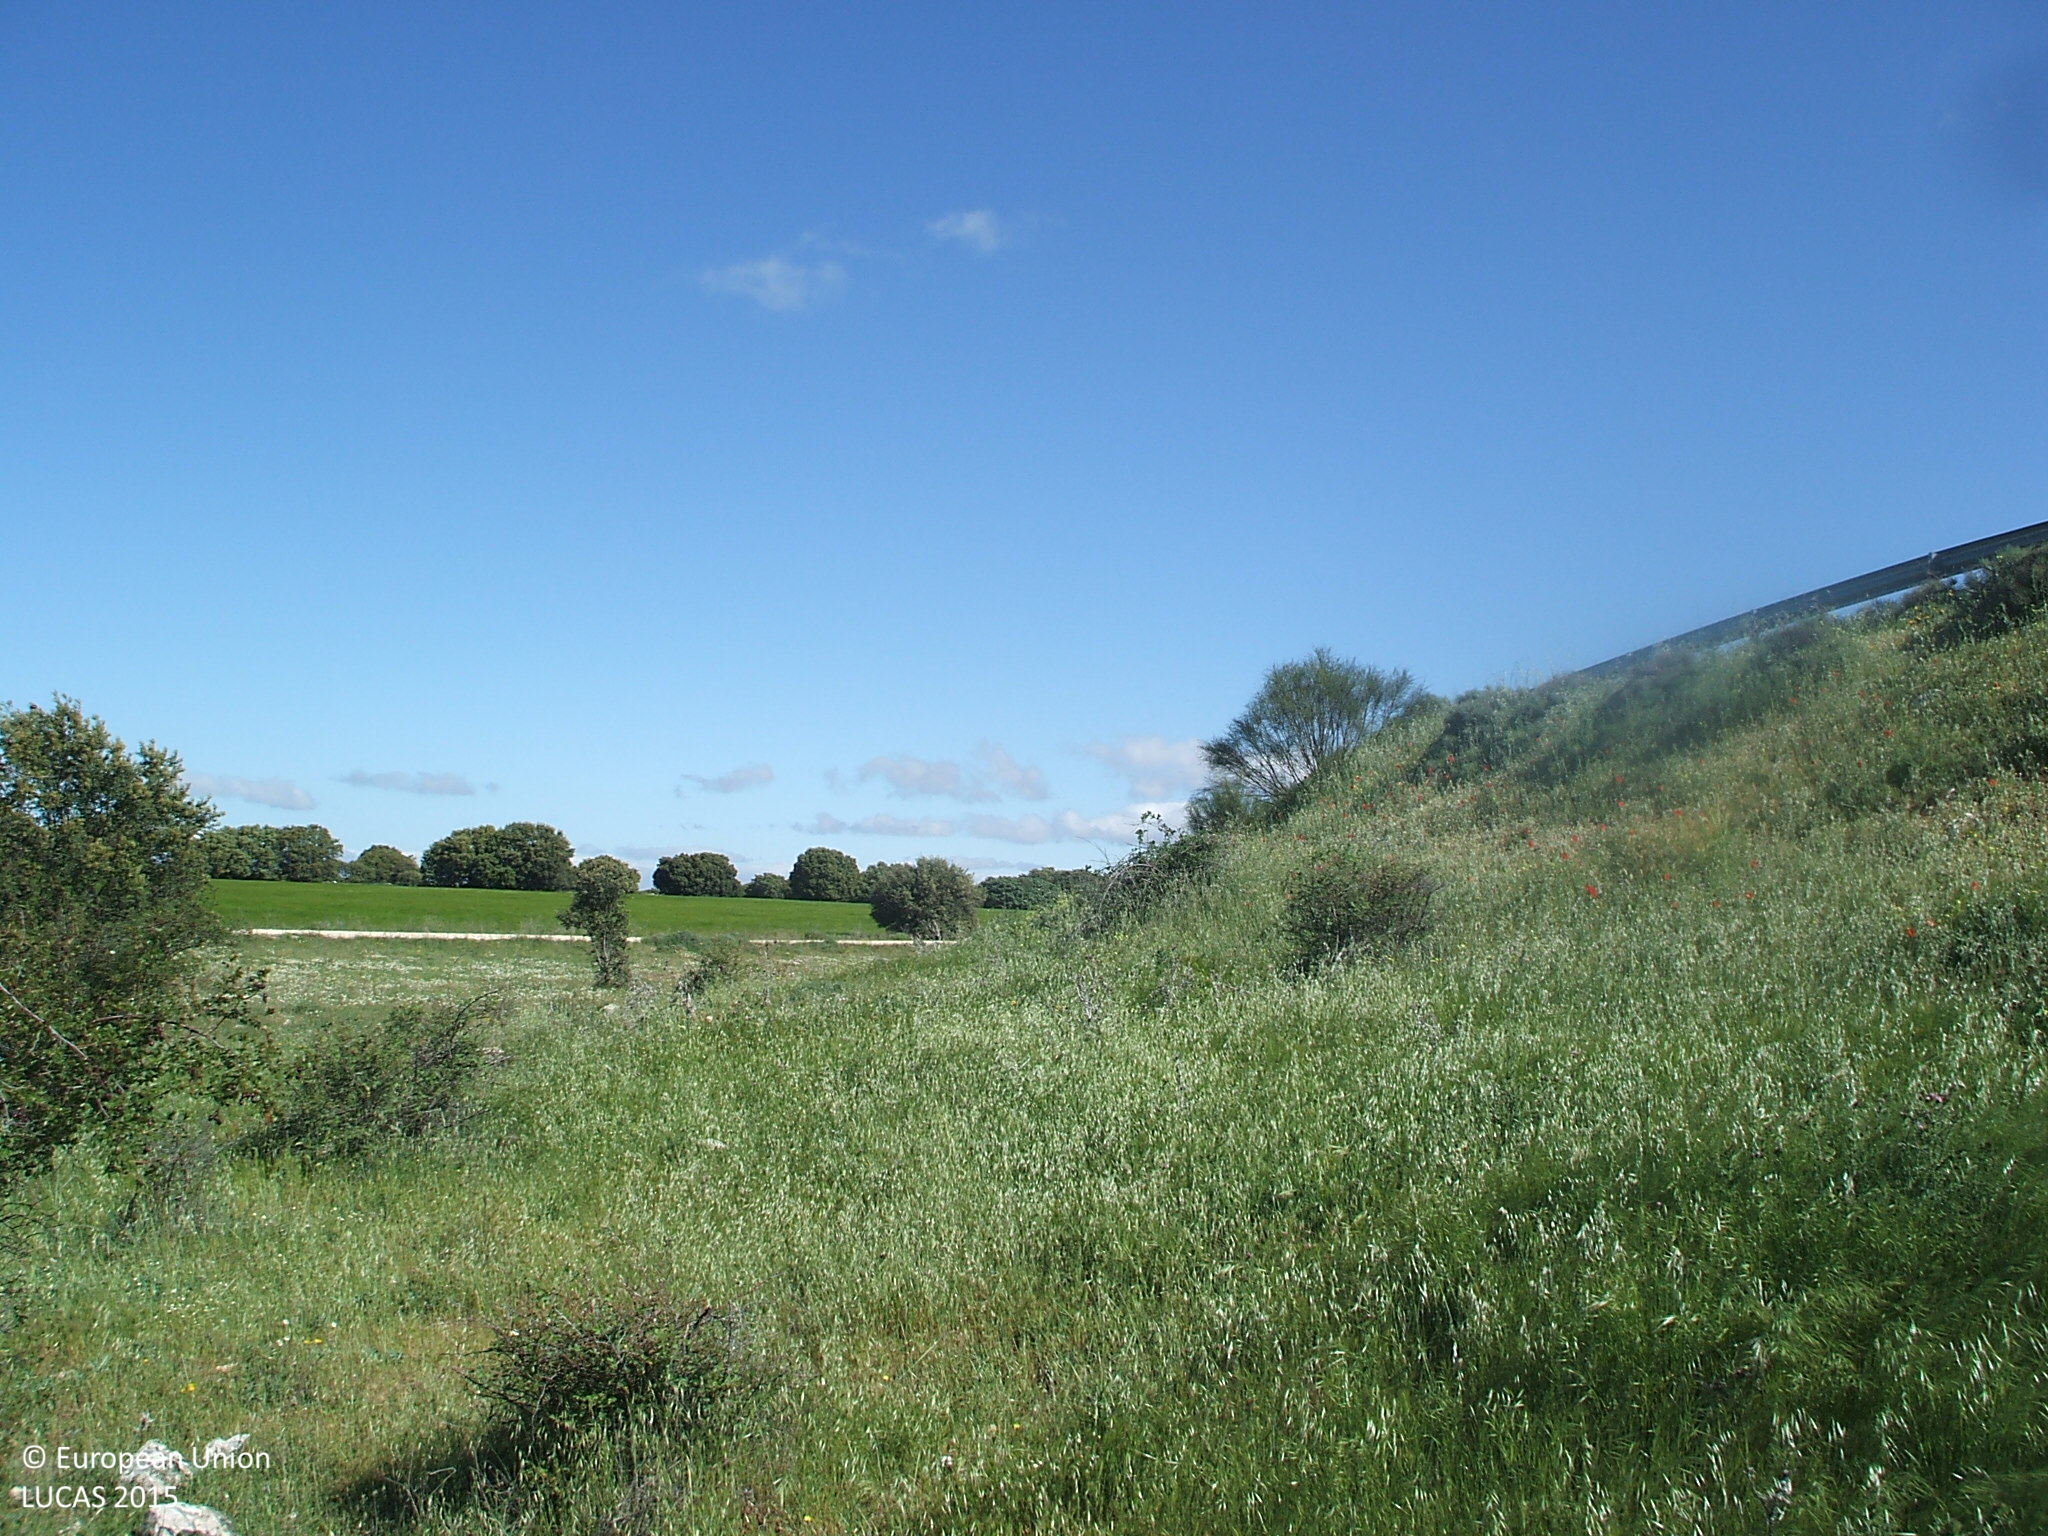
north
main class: Grassland
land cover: Grassland without tree/shrub cover
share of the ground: > 75 %
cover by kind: herbaceous plants 95 %, shrubs 5 %
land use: Semi-natural and natural areas not in use
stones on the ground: > 50 %
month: May
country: ES
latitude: 40.8207
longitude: -2.8967
